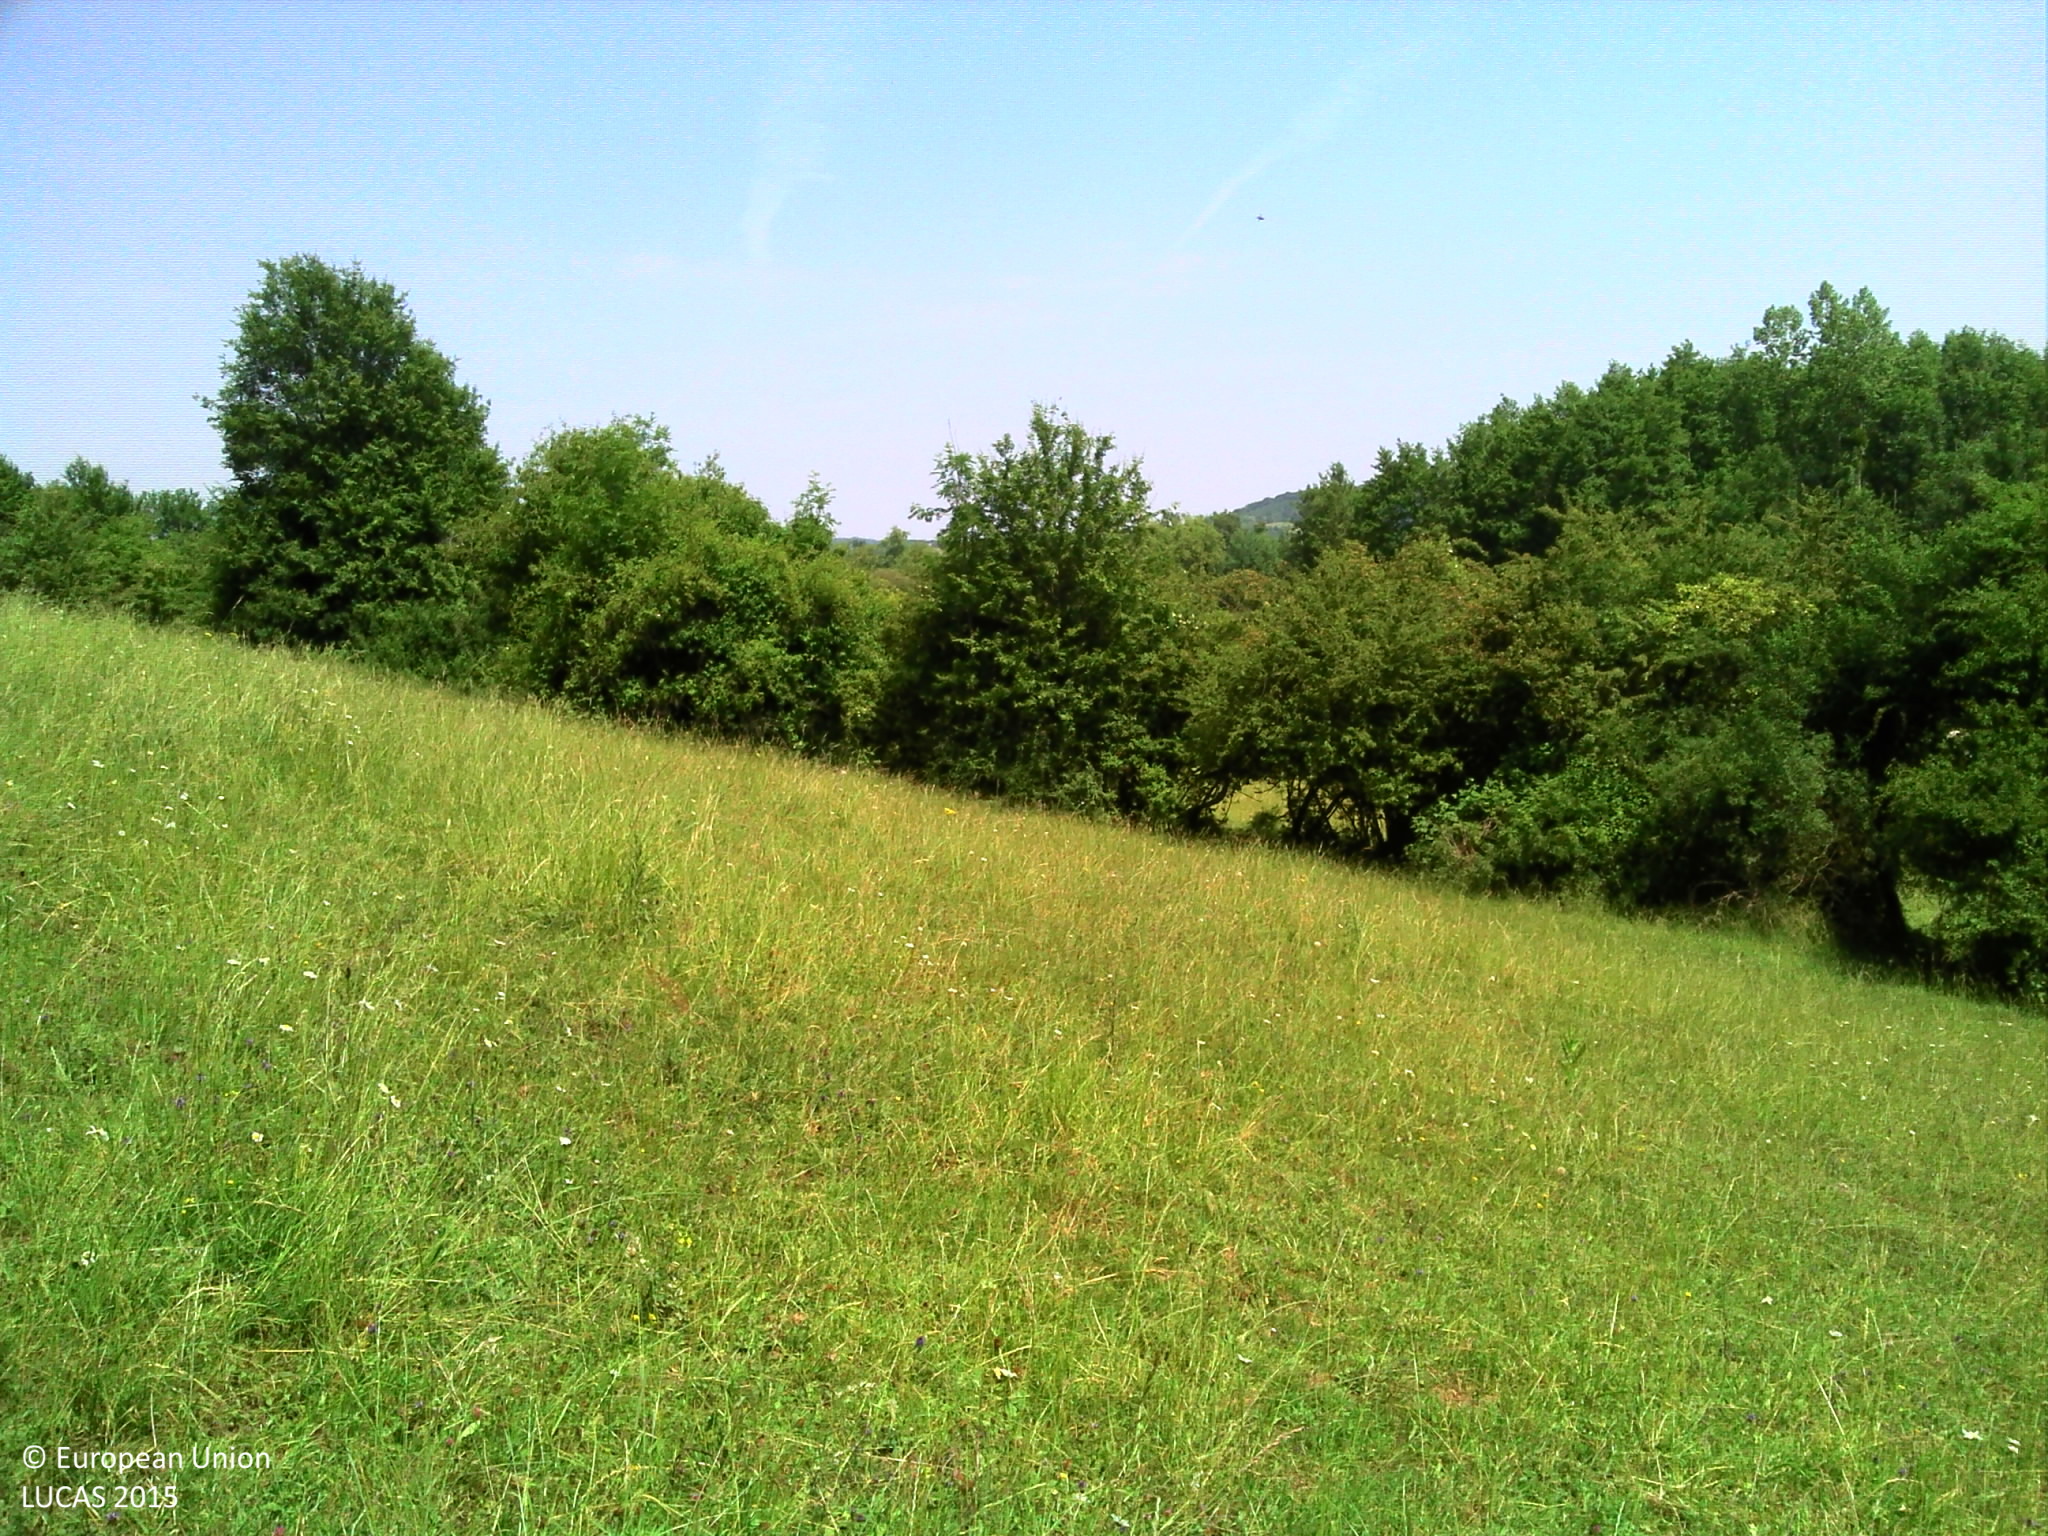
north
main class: Grassland
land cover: Grassland without tree/shrub cover
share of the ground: > 75 %
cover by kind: herbaceous plants 100 %
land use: Agriculture (excluding fallow land and kitchen gardens)
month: June
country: FR
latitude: 48.5030
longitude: 6.2783
